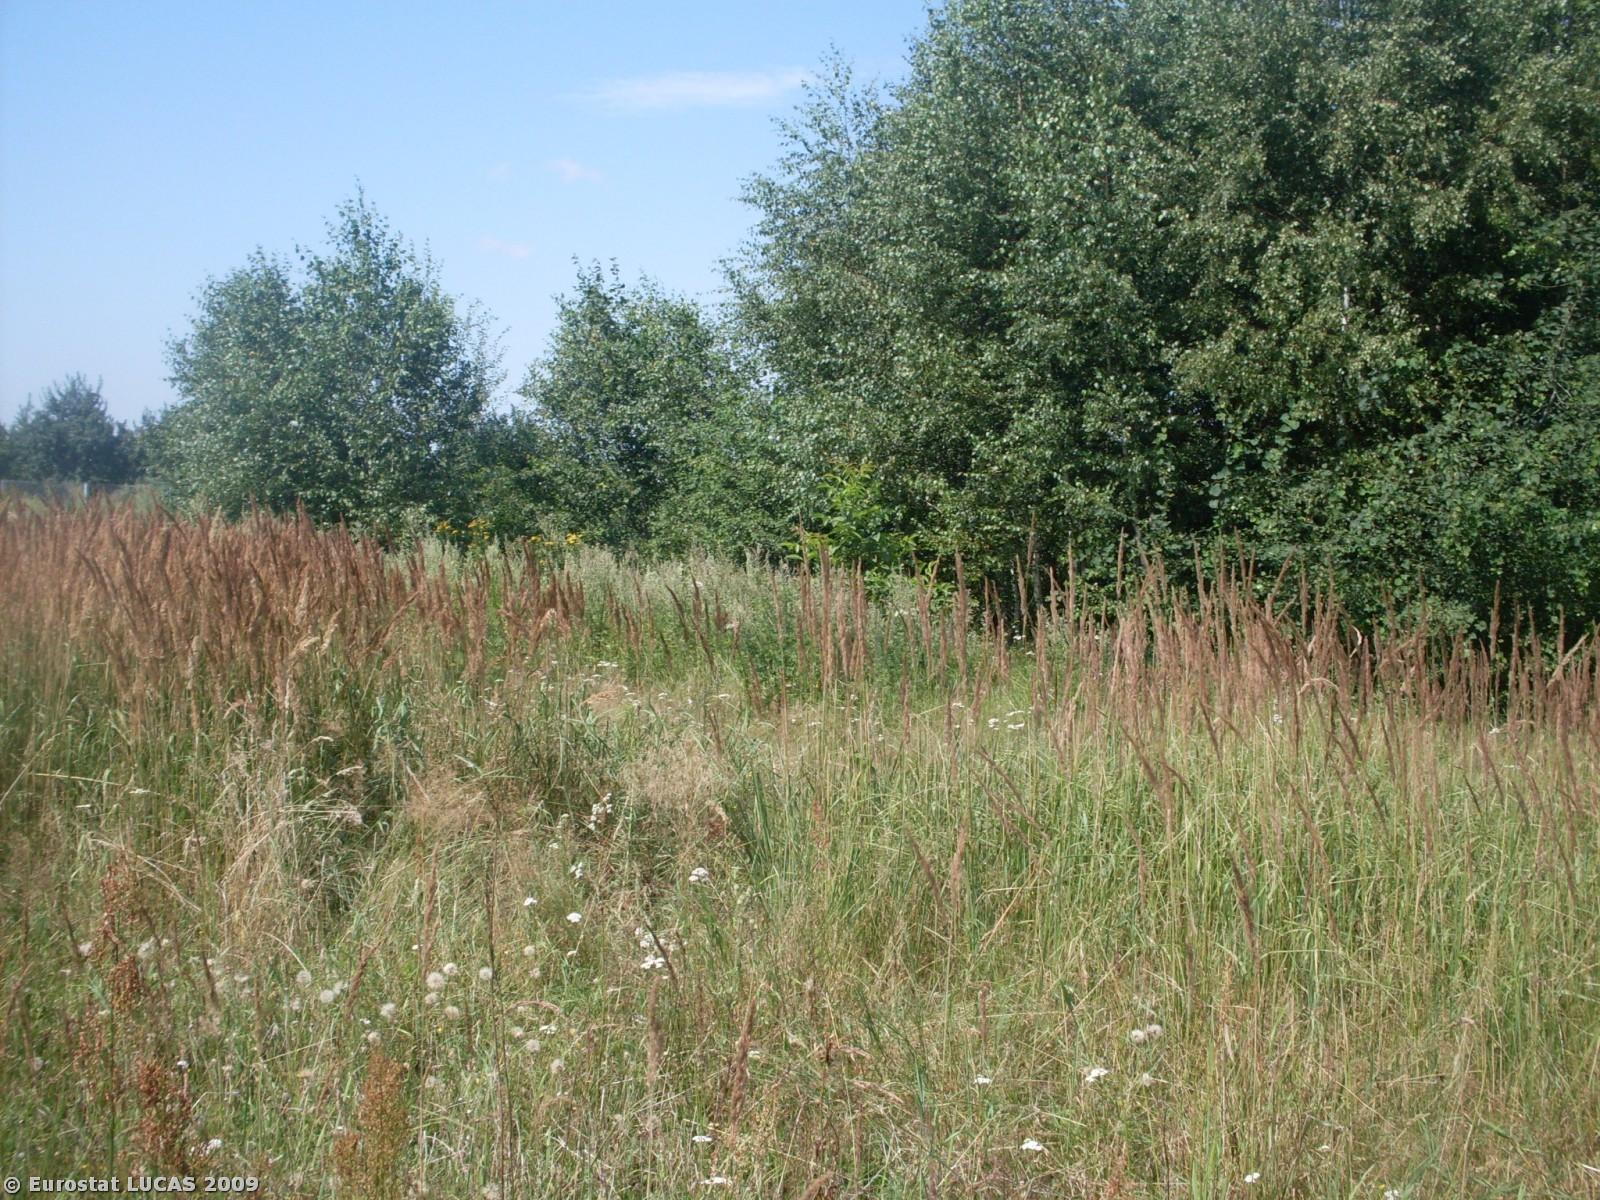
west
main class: Grassland
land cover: Grassland without tree/shrub cover
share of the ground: > 75 %
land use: Agriculture (excluding fallow land and kitchen gardens)
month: August
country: PL
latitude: 49.9793
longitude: 20.5951
